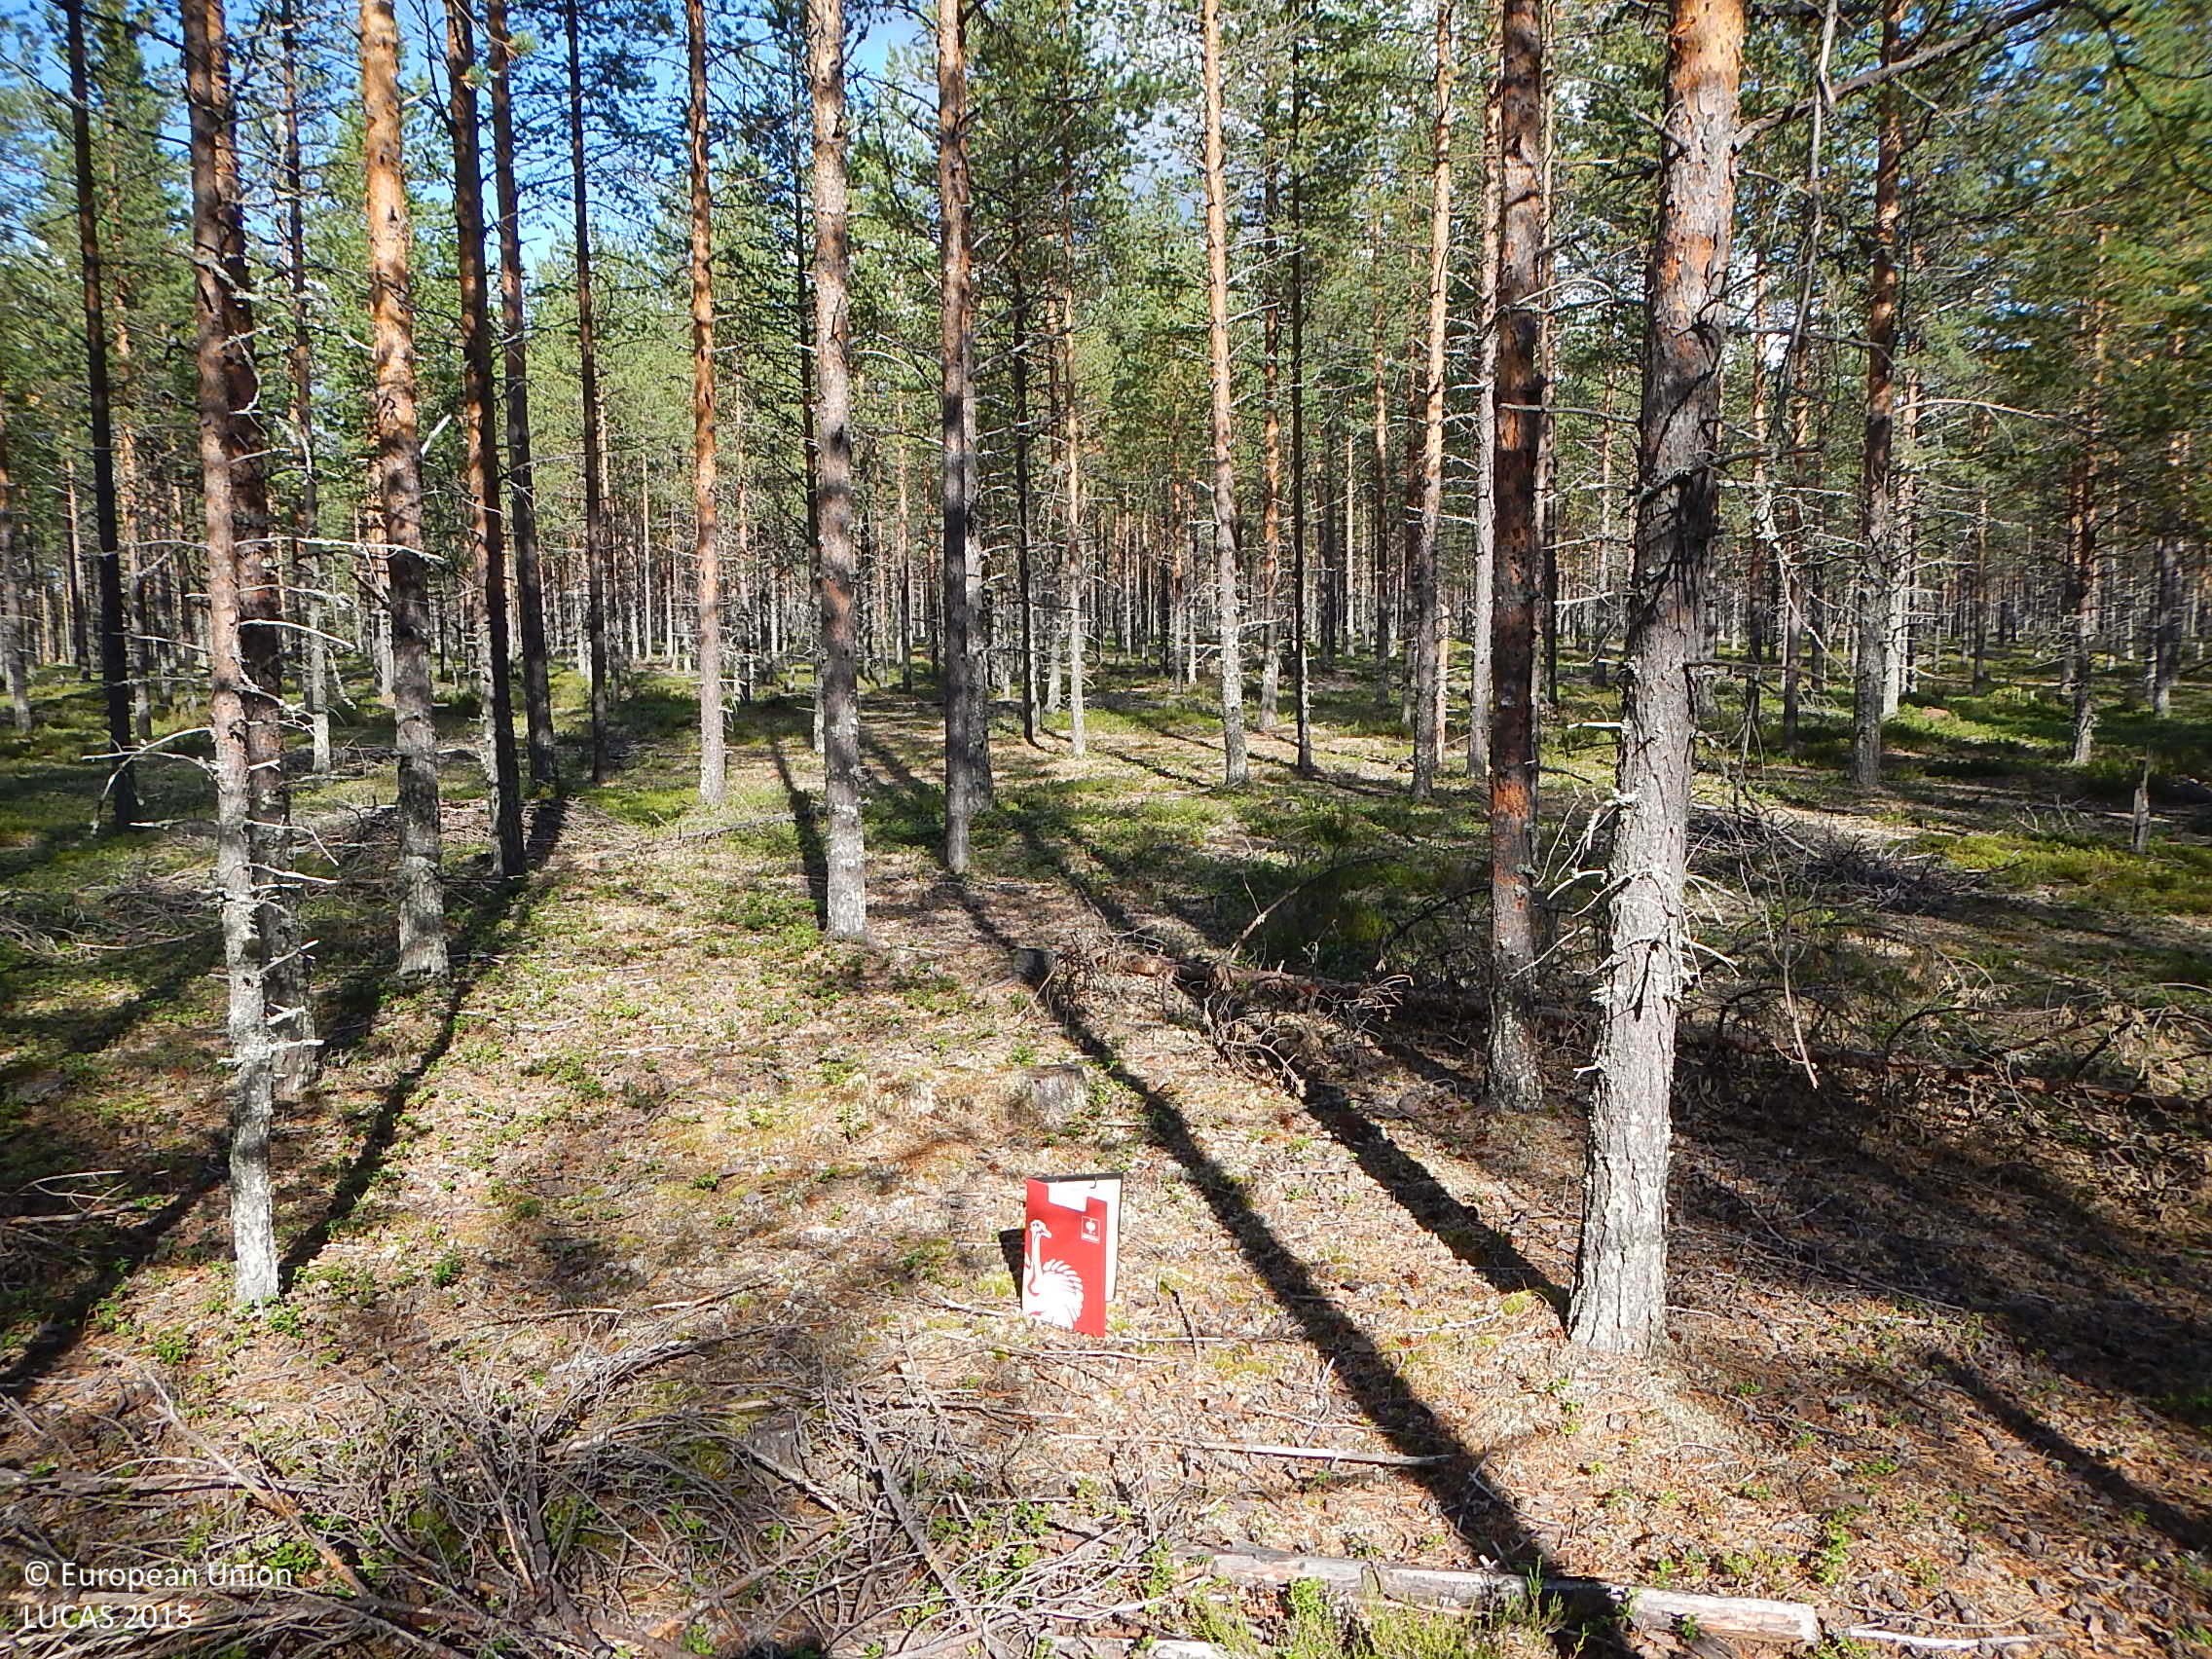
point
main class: Woodland
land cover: Pine dominated coniferous woodland
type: boreal forest
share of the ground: 50 - 75 %
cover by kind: coniferous forest trees 70 %, shrubs 20 %, herbaceous plants 10 %
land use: Forestry
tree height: > 5 m
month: August
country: FI
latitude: 65.3928
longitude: 26.9237
